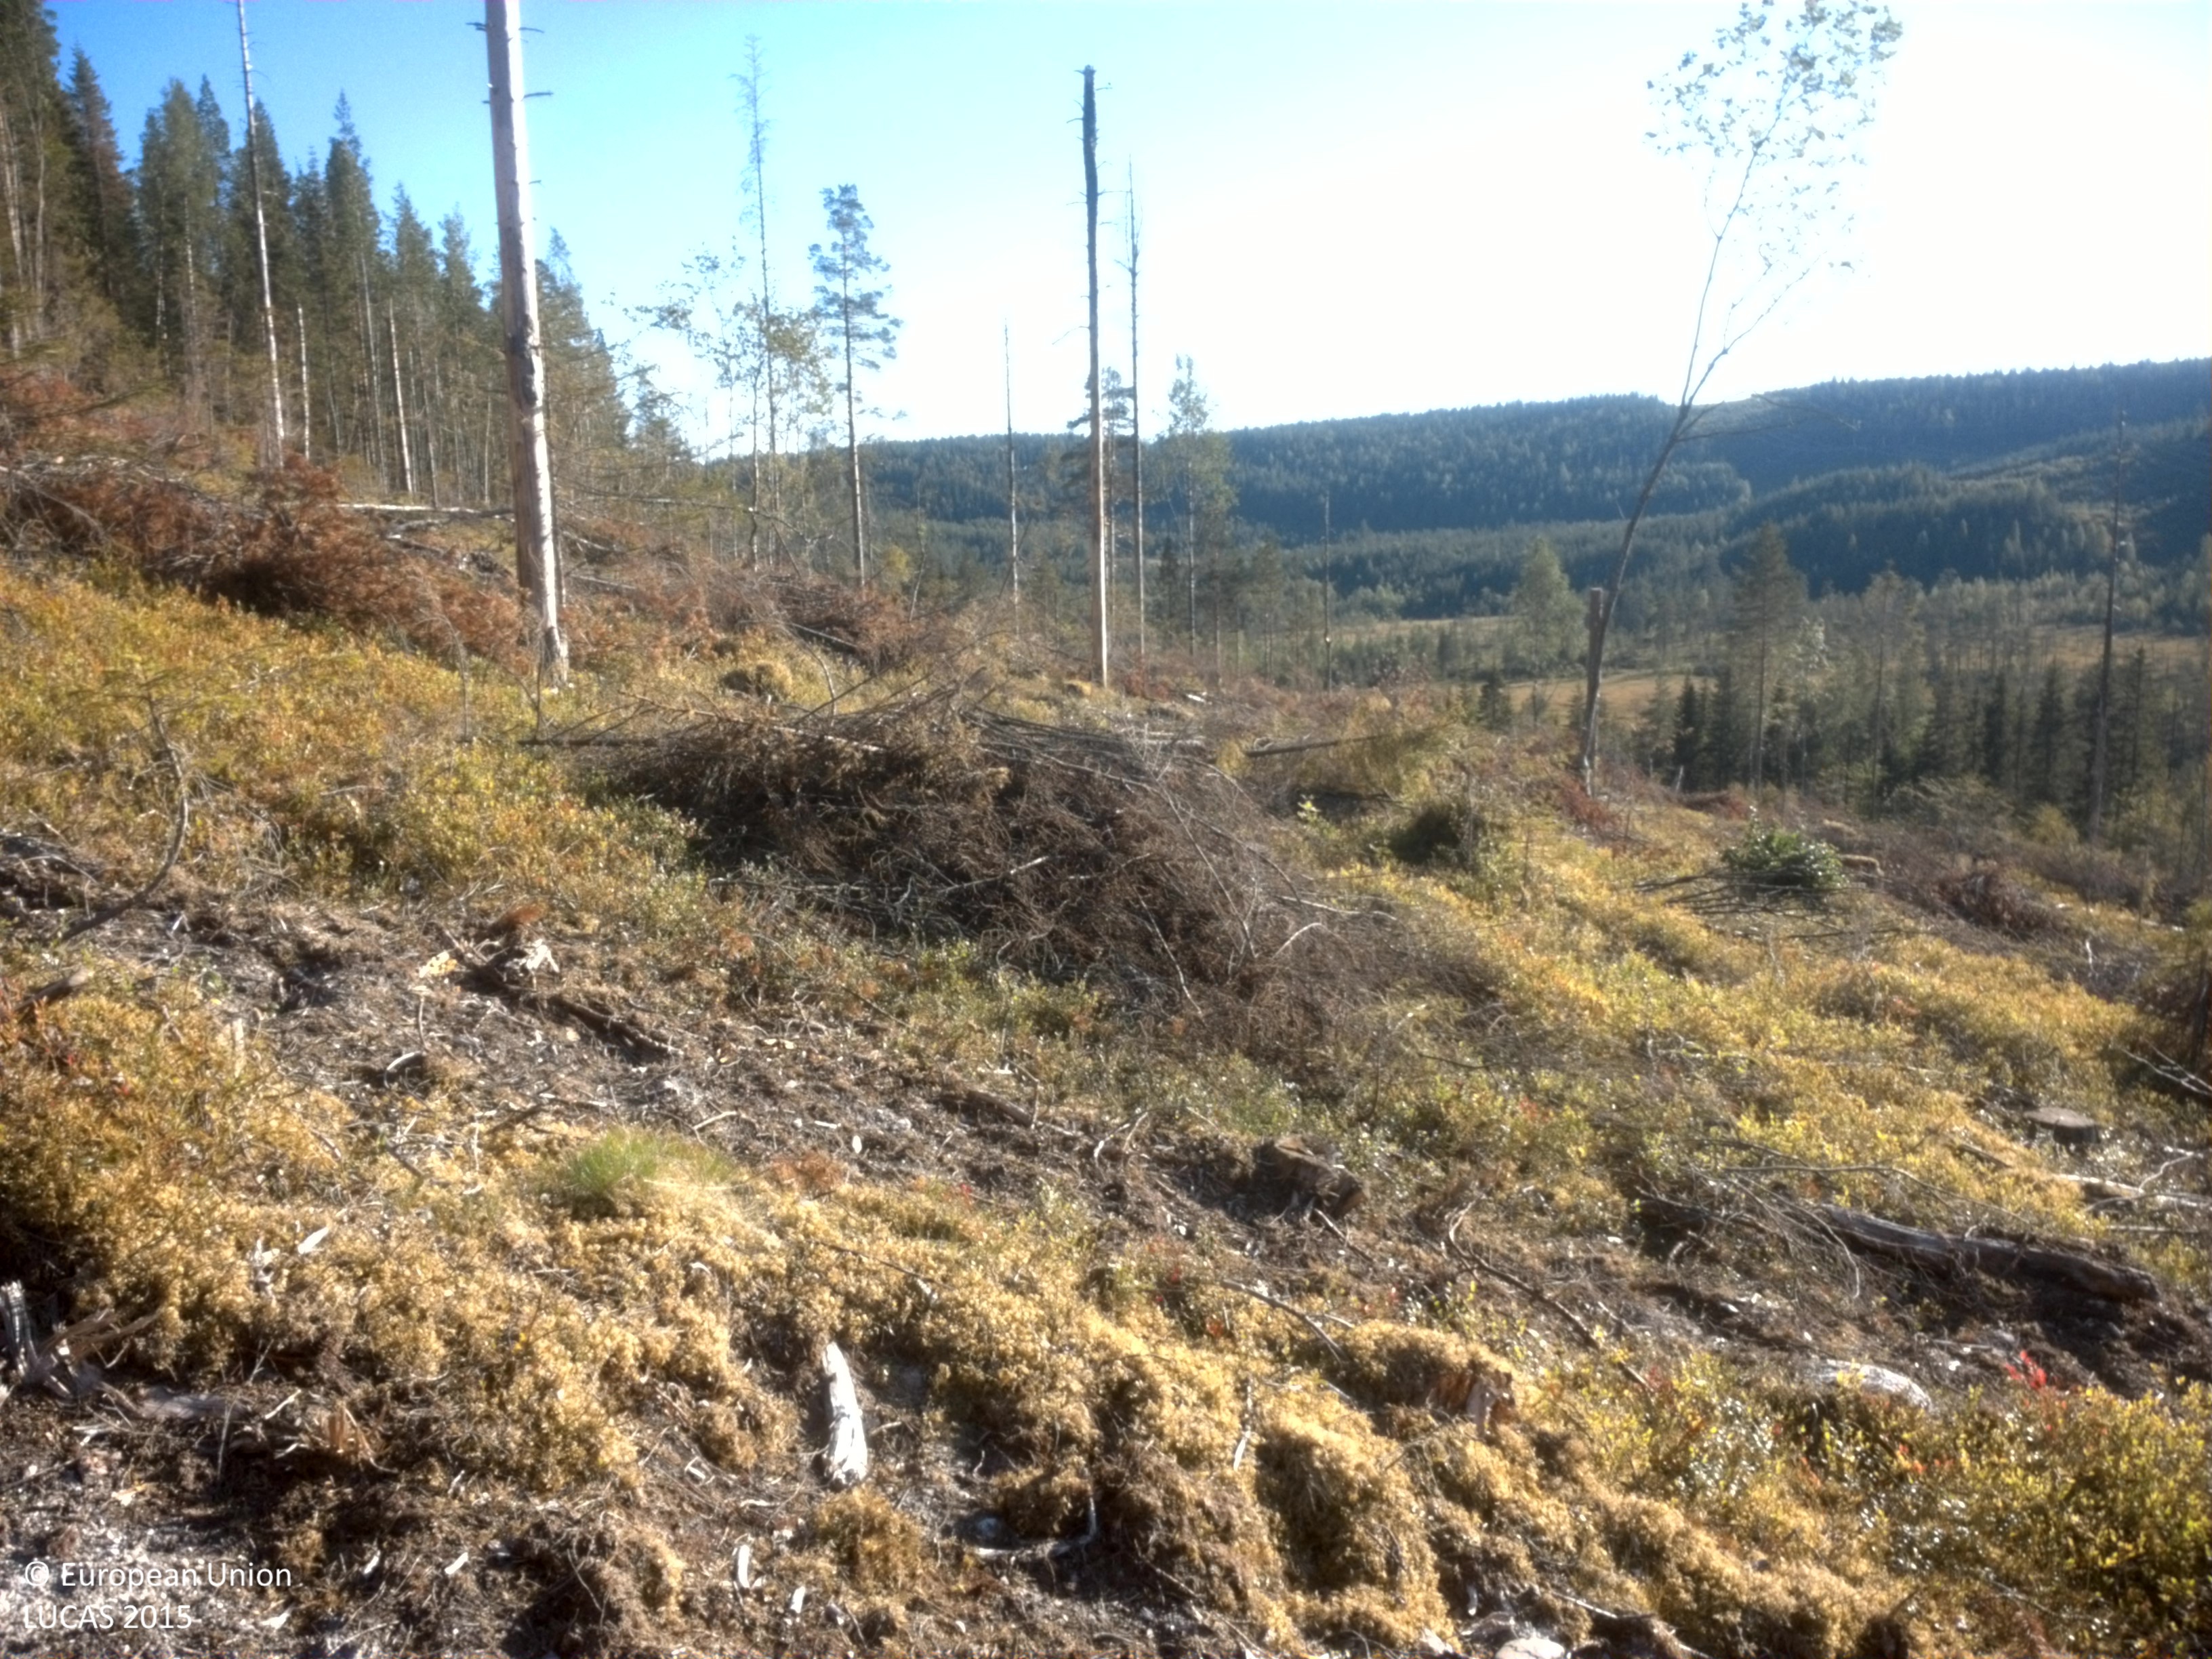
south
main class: Shrubland
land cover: Shrubland with sparse tree cover
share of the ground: > 75 %
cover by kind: shrubs 85 %, lichens and mosses 10 %, coniferous forest trees 5 %
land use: Forestry
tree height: > 5 m
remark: Clear cut
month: August
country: SE
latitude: 64.6275
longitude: 19.1092
